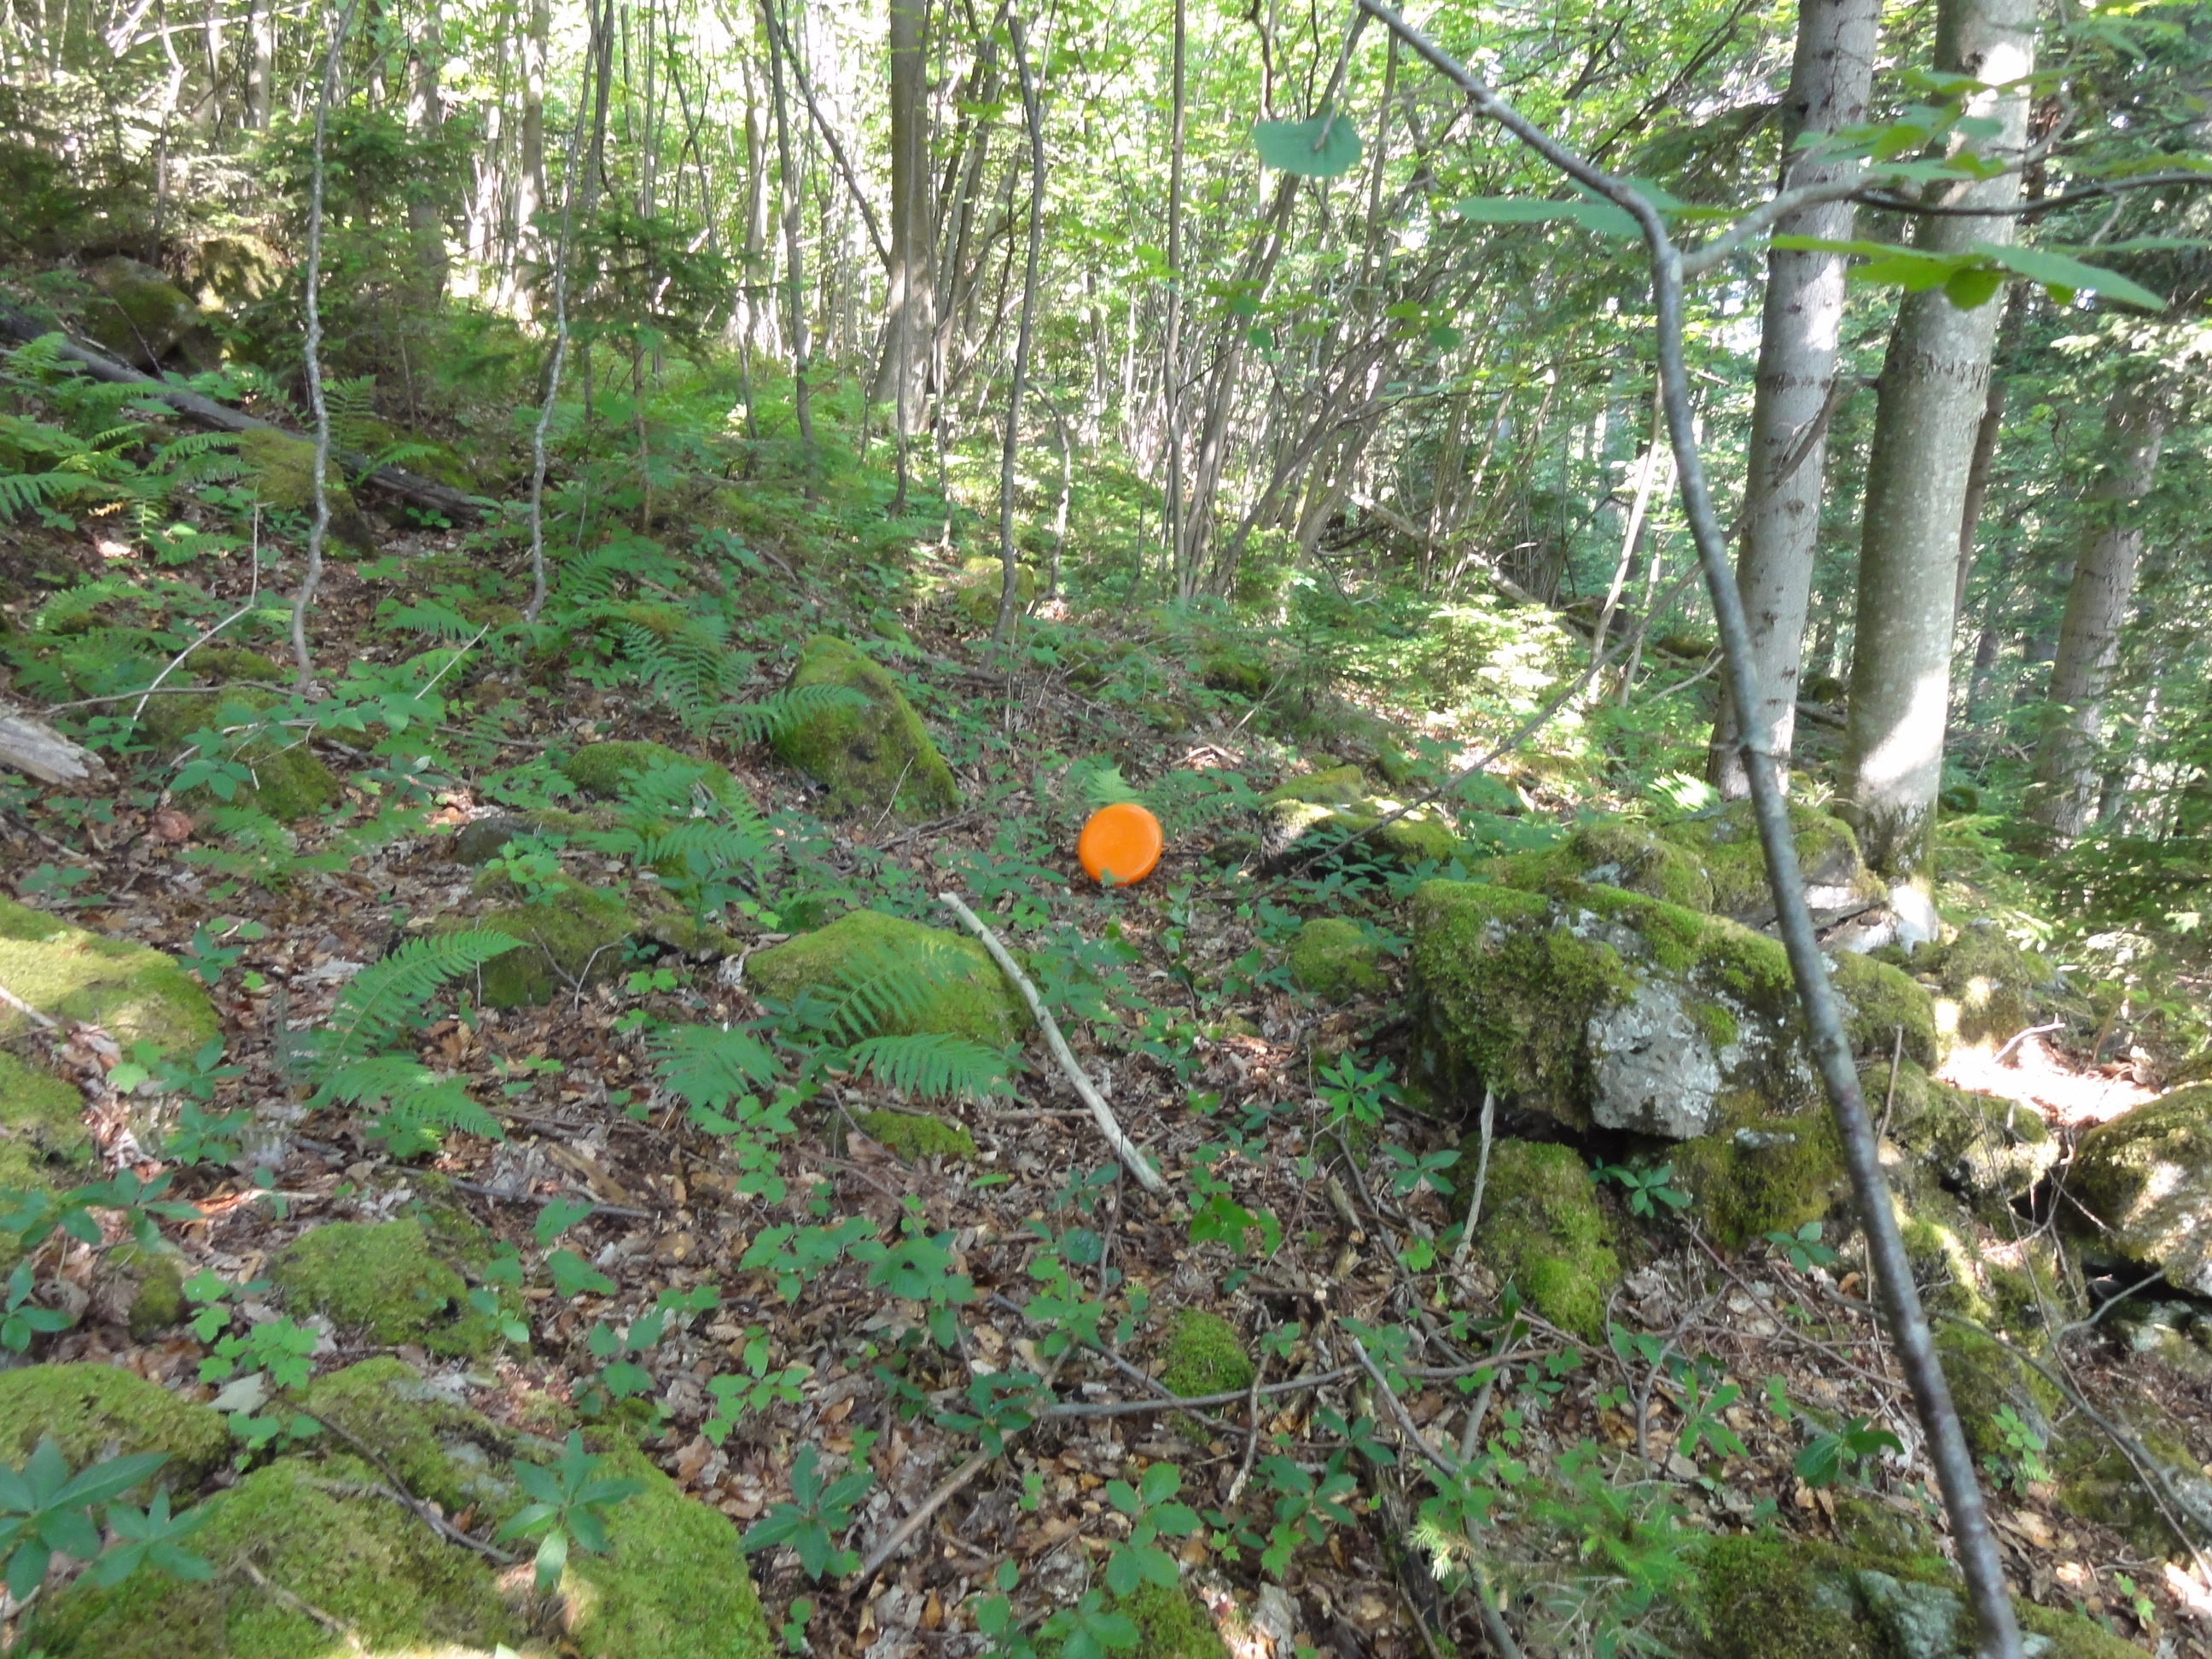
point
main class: Woodland
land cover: Spruce dominated mixed woodland
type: mountainous beech forest
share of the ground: > 75 %
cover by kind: broadleaved forest trees 70 %, coniferous forest trees 30 %
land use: Forestry
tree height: > 5 m
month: June
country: SI
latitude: 46.2767
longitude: 14.8637
